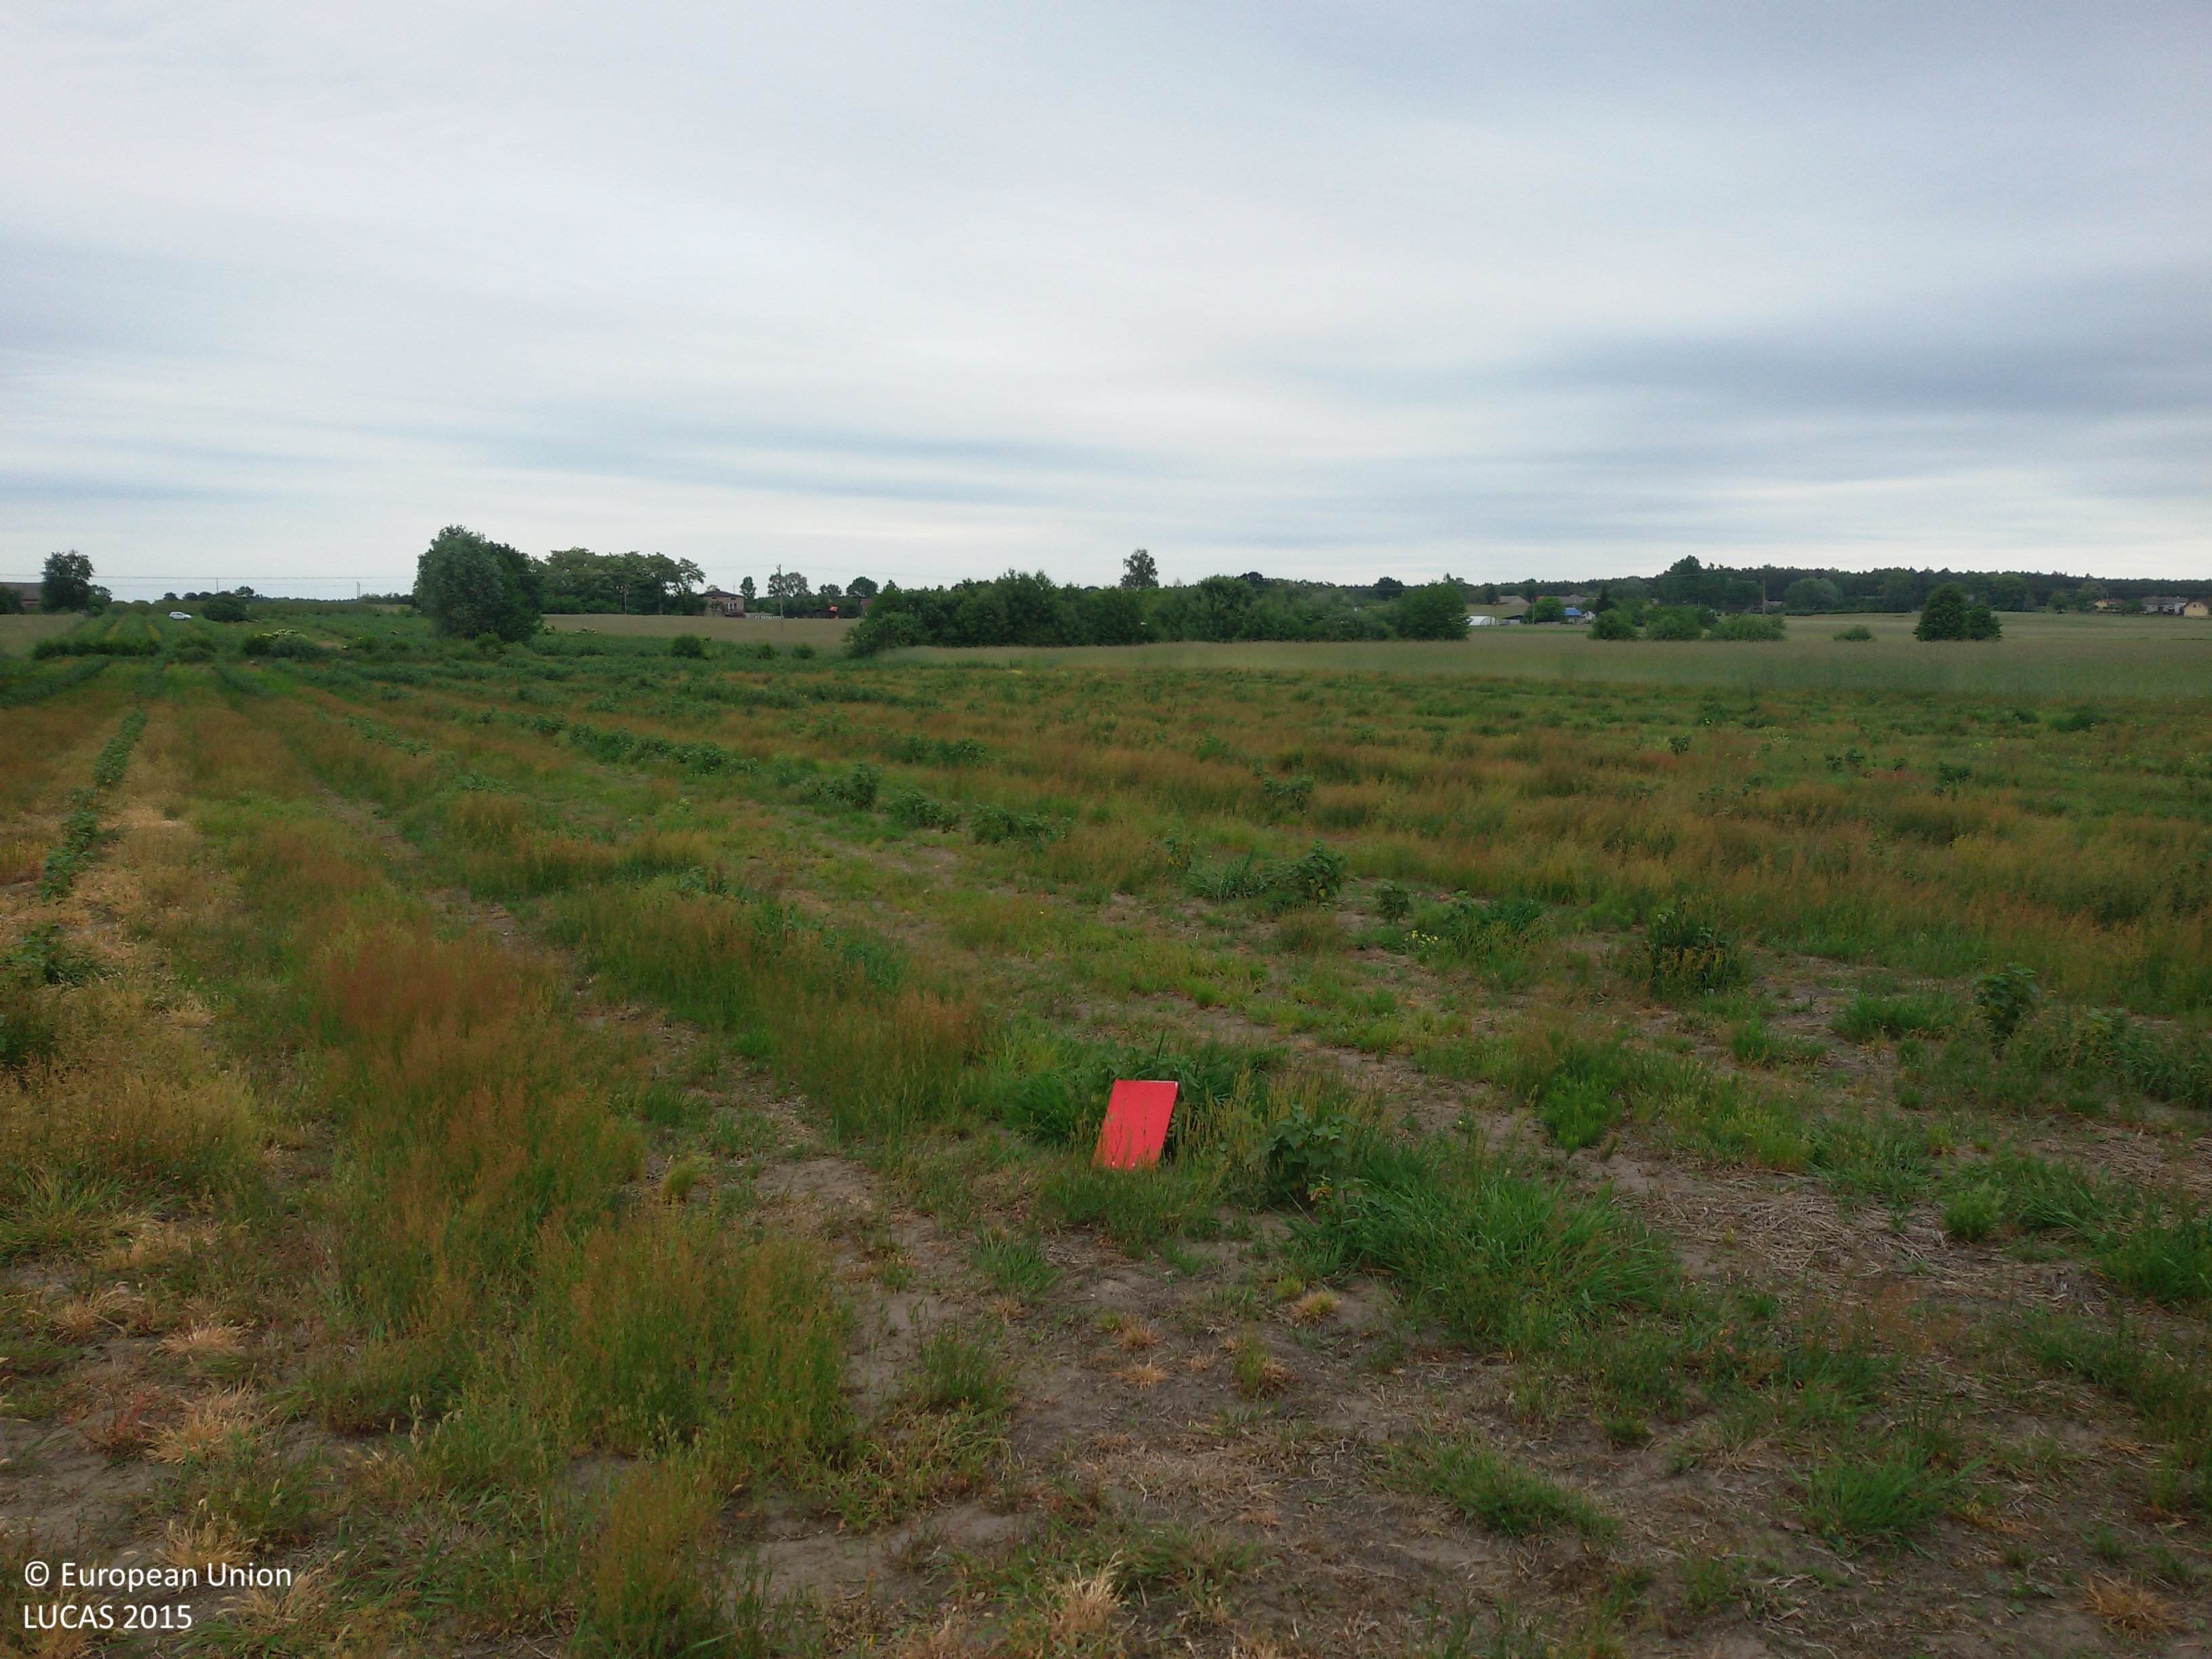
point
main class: Cropland
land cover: Other fruit trees and berries
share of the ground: 25 - 50 %
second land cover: Grassland without tree/shrub cover
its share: 50 - 75 %
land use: Agriculture (excluding fallow land and kitchen gardens)
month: June
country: PL
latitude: 51.9510
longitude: 19.8230
